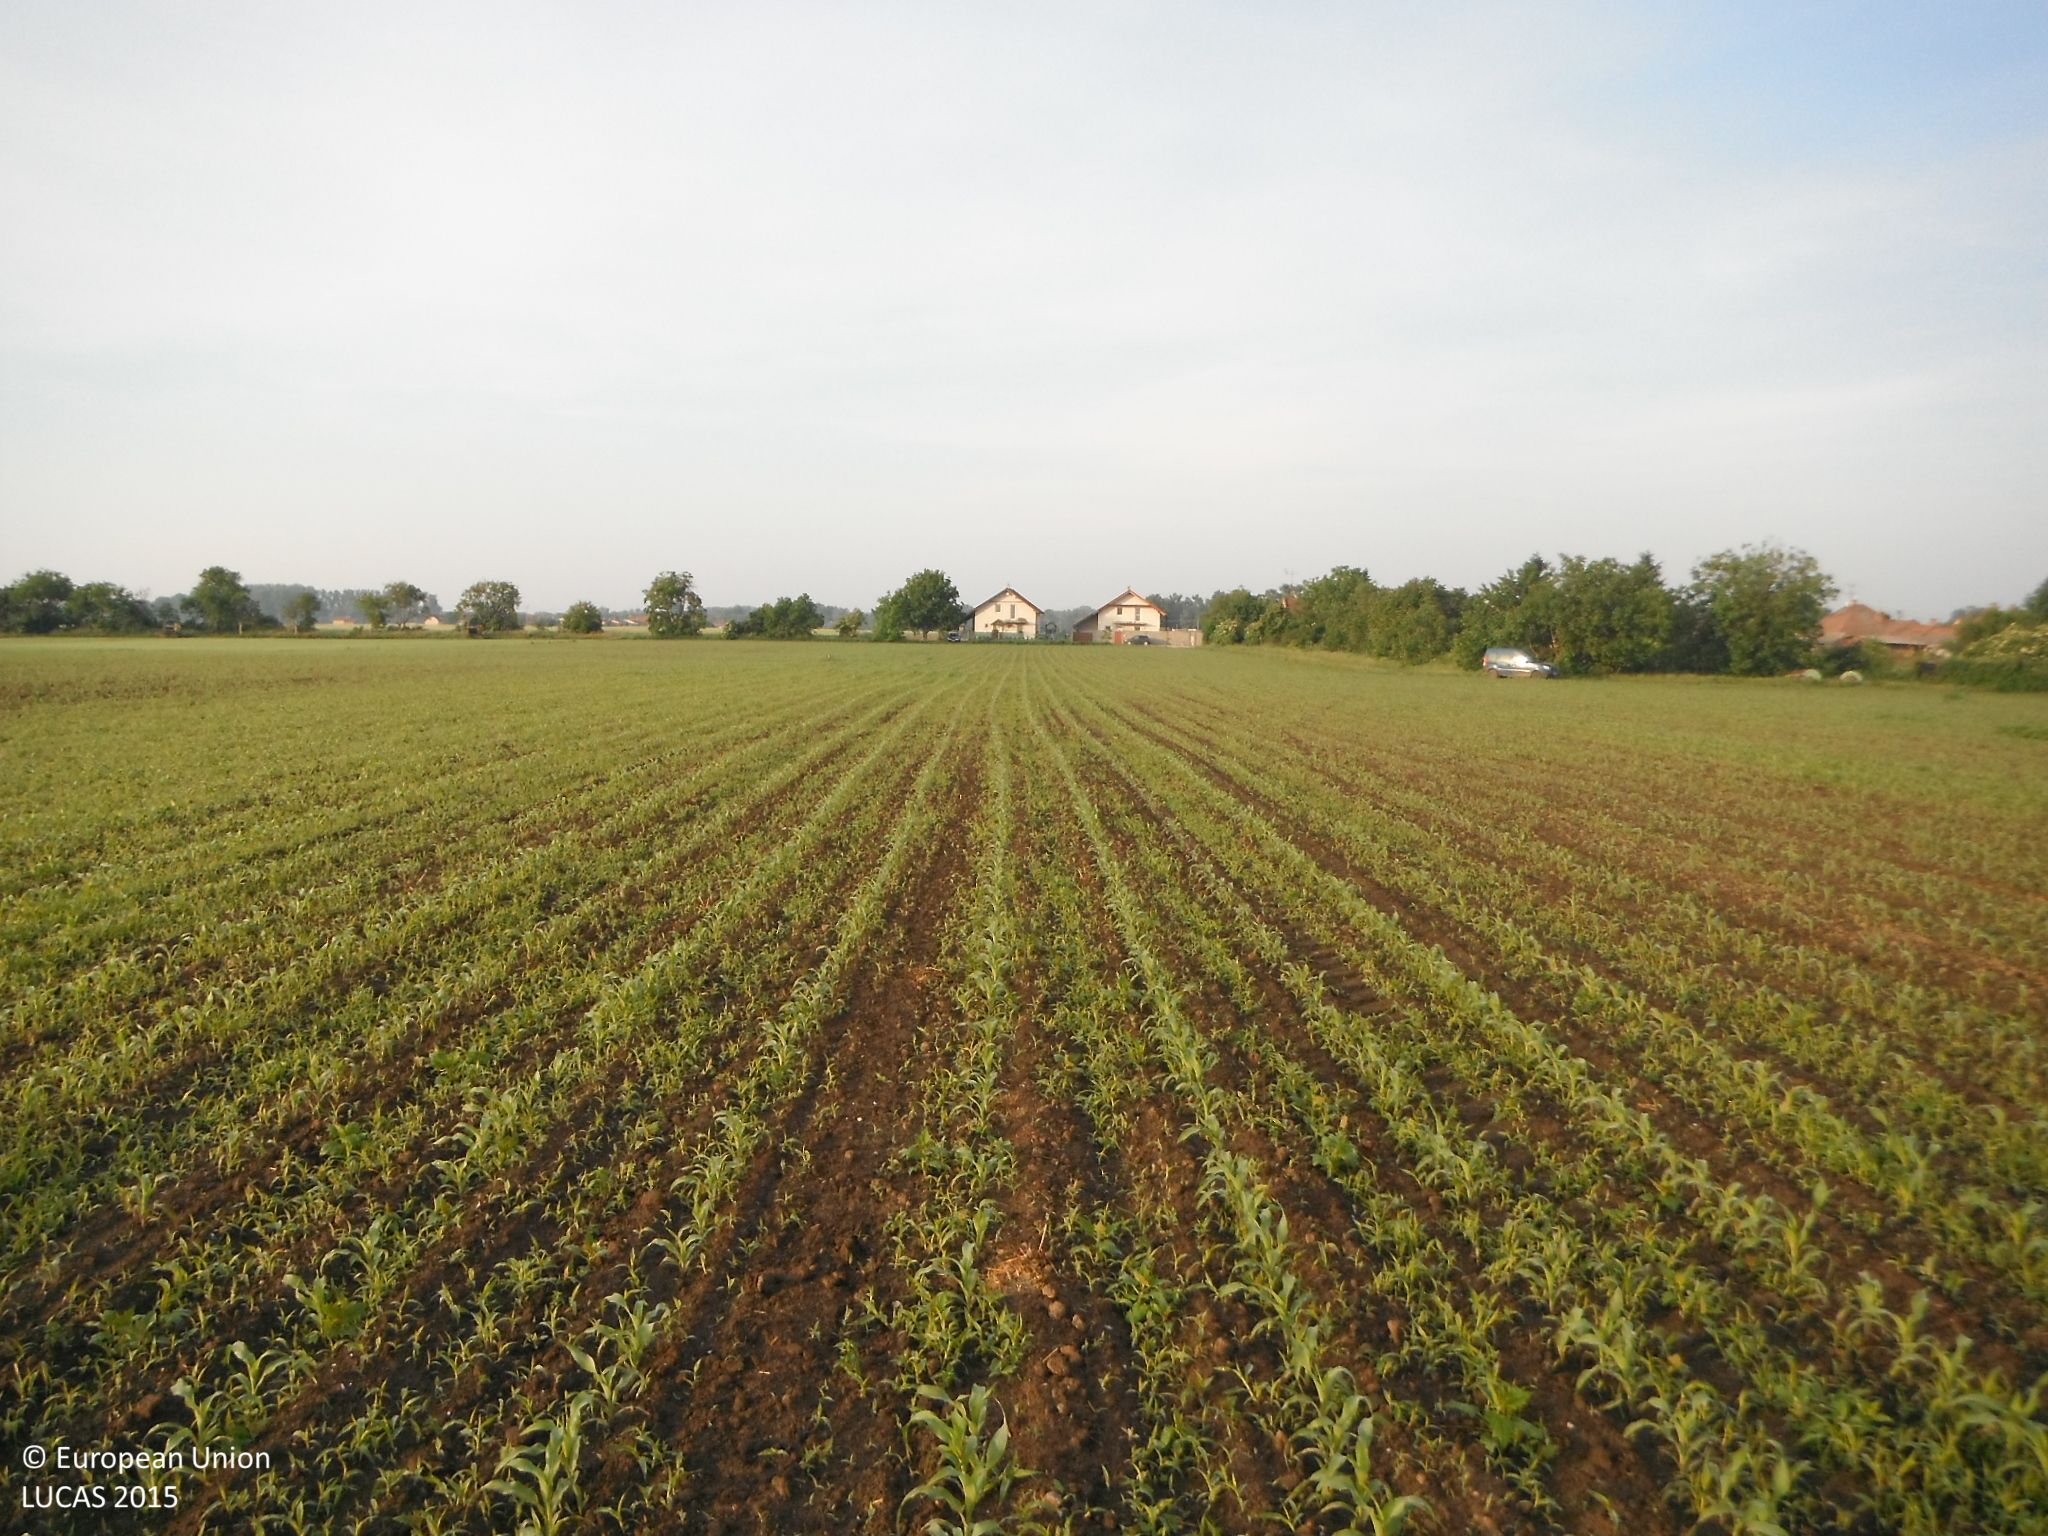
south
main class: Cropland
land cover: Maize
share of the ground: 10 - 25 %
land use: Agriculture (excluding fallow land and kitchen gardens)
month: May
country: SK
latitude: 48.1919
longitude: 17.3948
